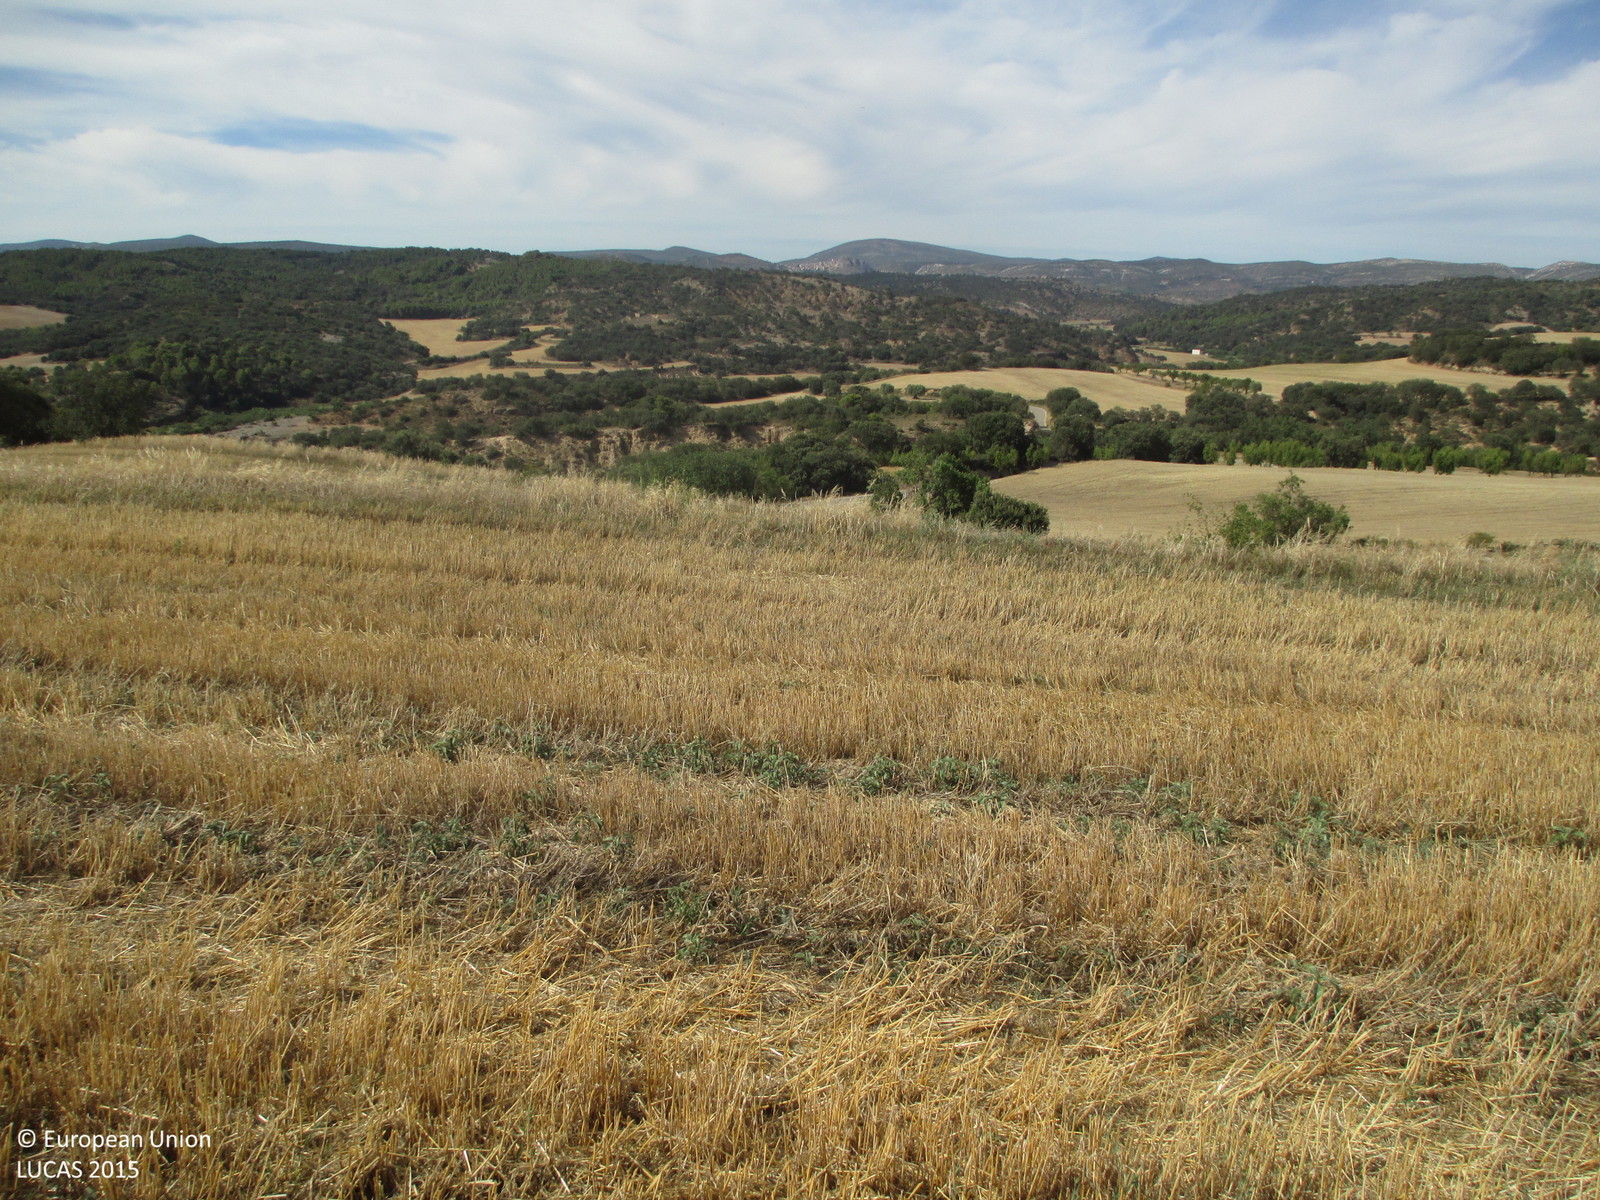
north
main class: Cropland
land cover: Barley
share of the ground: < 10 %
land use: Agriculture (excluding fallow land and kitchen gardens)
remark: Harvested field
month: July
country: ES
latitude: 41.9577
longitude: 0.3681
